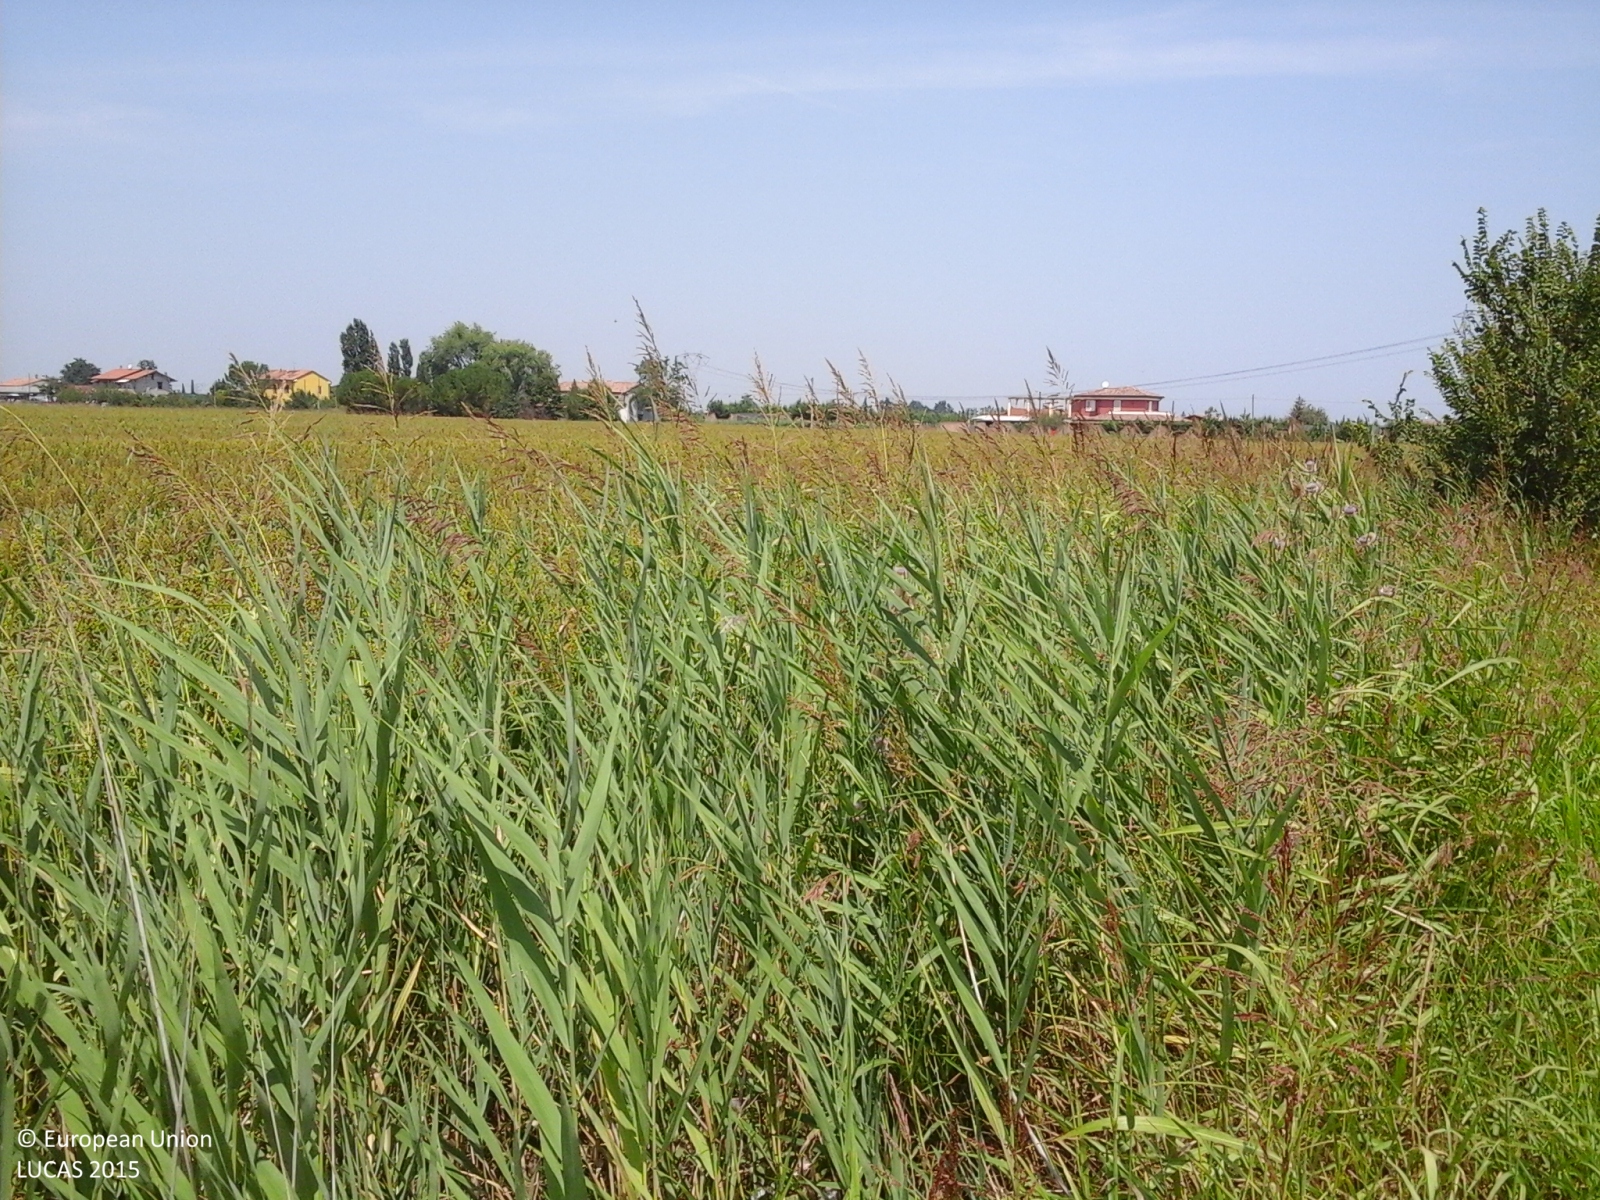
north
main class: Cropland
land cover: Other cereals
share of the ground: > 75 %
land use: Agriculture (excluding fallow land and kitchen gardens)
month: July
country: IT
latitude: 44.1242
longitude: 12.4065
